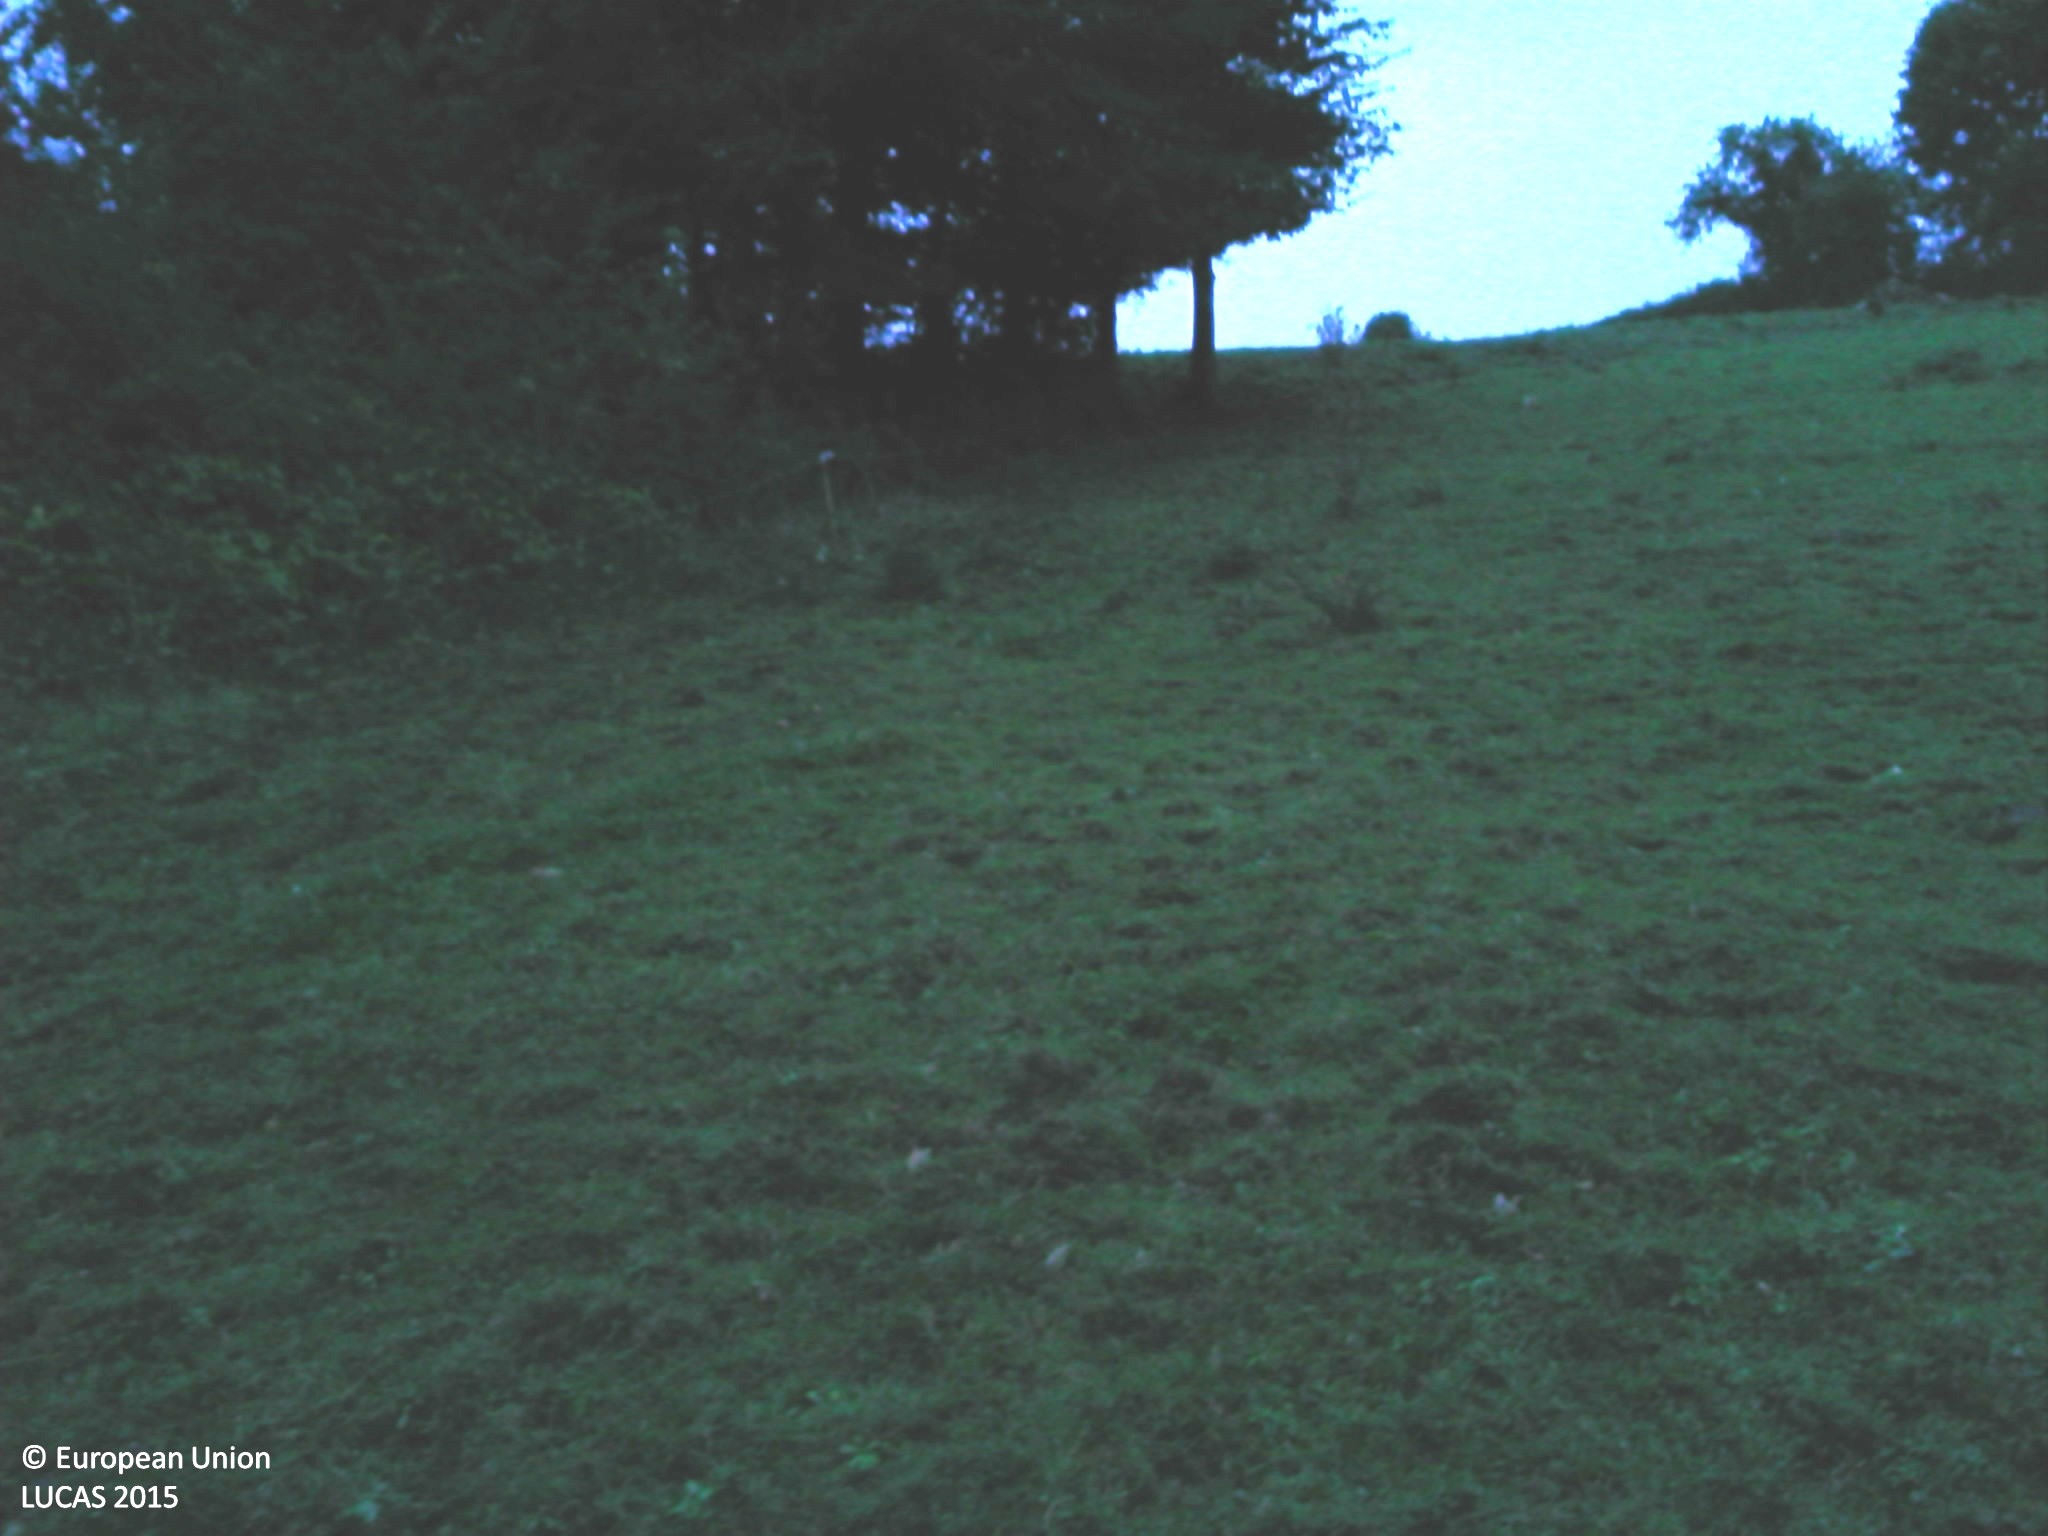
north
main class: Grassland
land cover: Grassland without tree/shrub cover
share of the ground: 50 - 75 %
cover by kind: herbaceous plants 70 %, unconsolidated bare surface 30 %
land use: Agriculture (excluding fallow land and kitchen gardens)
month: September
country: FR
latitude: 46.5457
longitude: 1.6047
